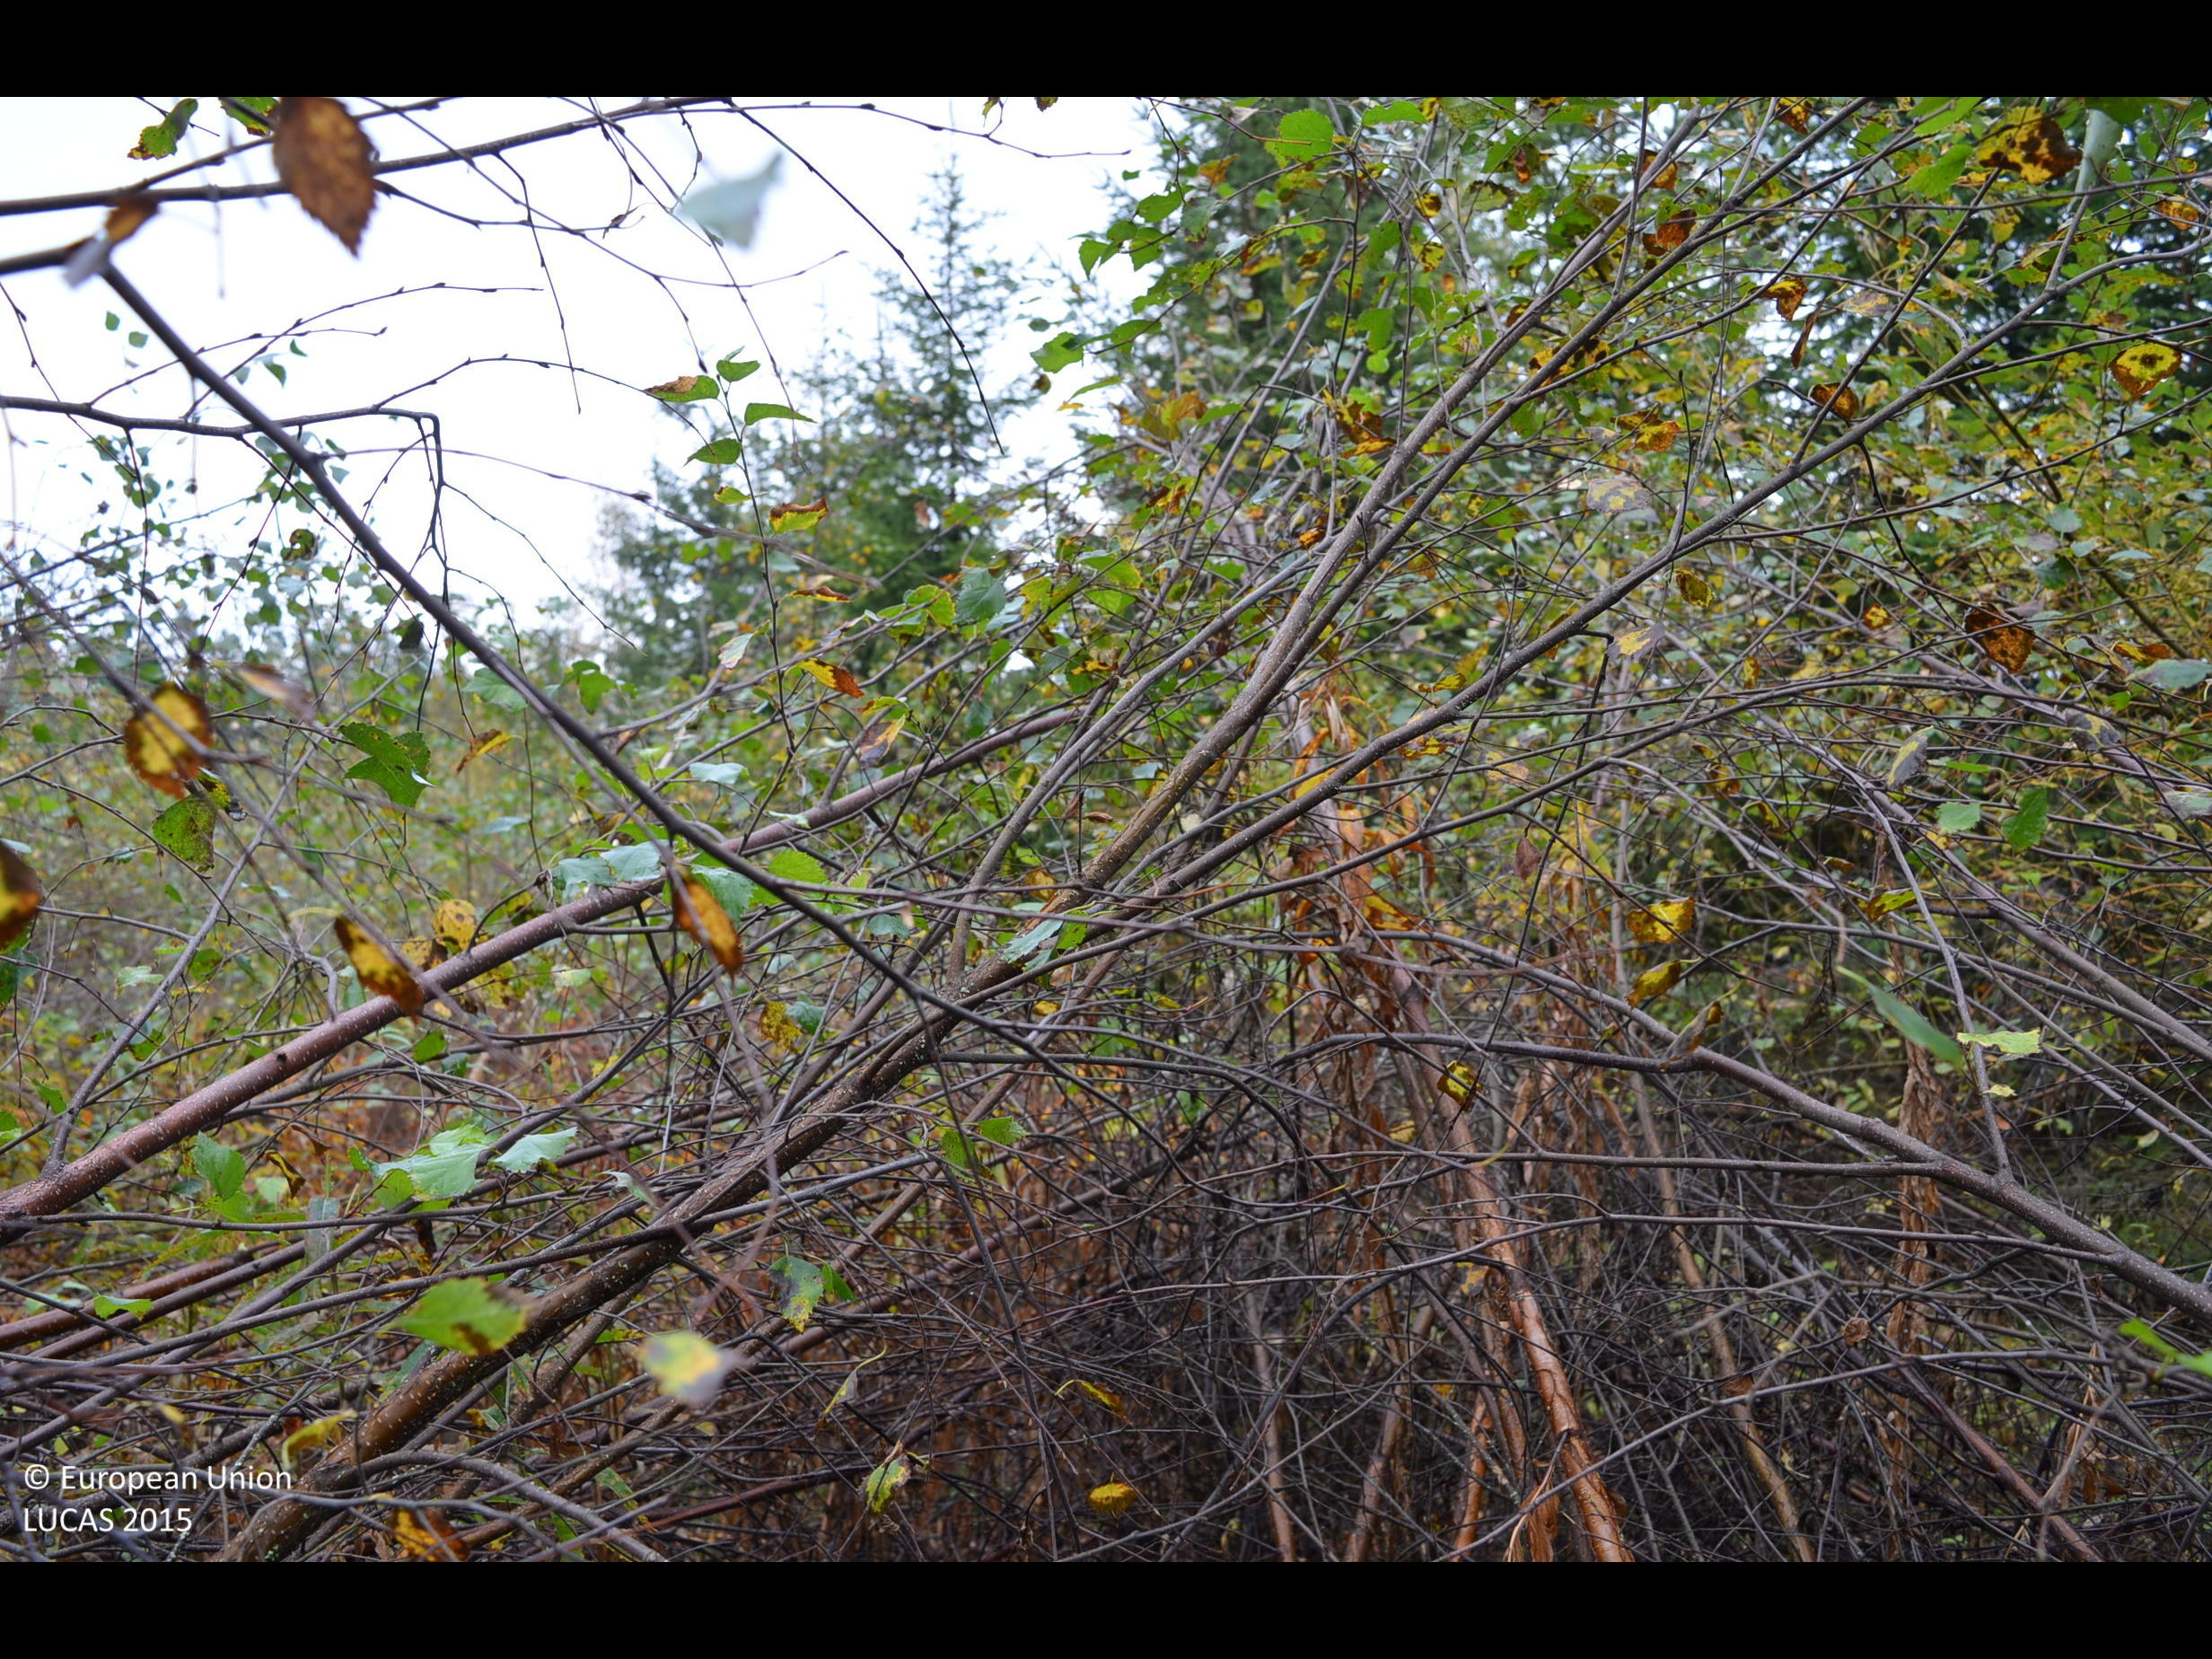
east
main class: Woodland
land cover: Broadleaved woodland
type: boreal forest
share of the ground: > 75 %
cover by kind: broadleaved forest trees 80 %, coniferous forest trees 15 %, shrubs 5 %
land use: Forestry
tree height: < 5 m
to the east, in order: Broadleaved woodland; Ditches and canals; Grassland with sparse tree/shrub cover; Ditches and canals; Spruce dominated mixed woodland; Shrubland without tree cover; Ditches and canals; Shrubland without tree cover; Ditches and canals; Abandoned hedges; Grassland without tree/shrub cover; Spruce dominated mixed woodland; Ditches and canals; Spruce dominated mixed woodland; Ditches and canals; Shruby margins; Tracks; Temporary grasslands
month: September
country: FI
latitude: 62.6881
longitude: 23.8083
